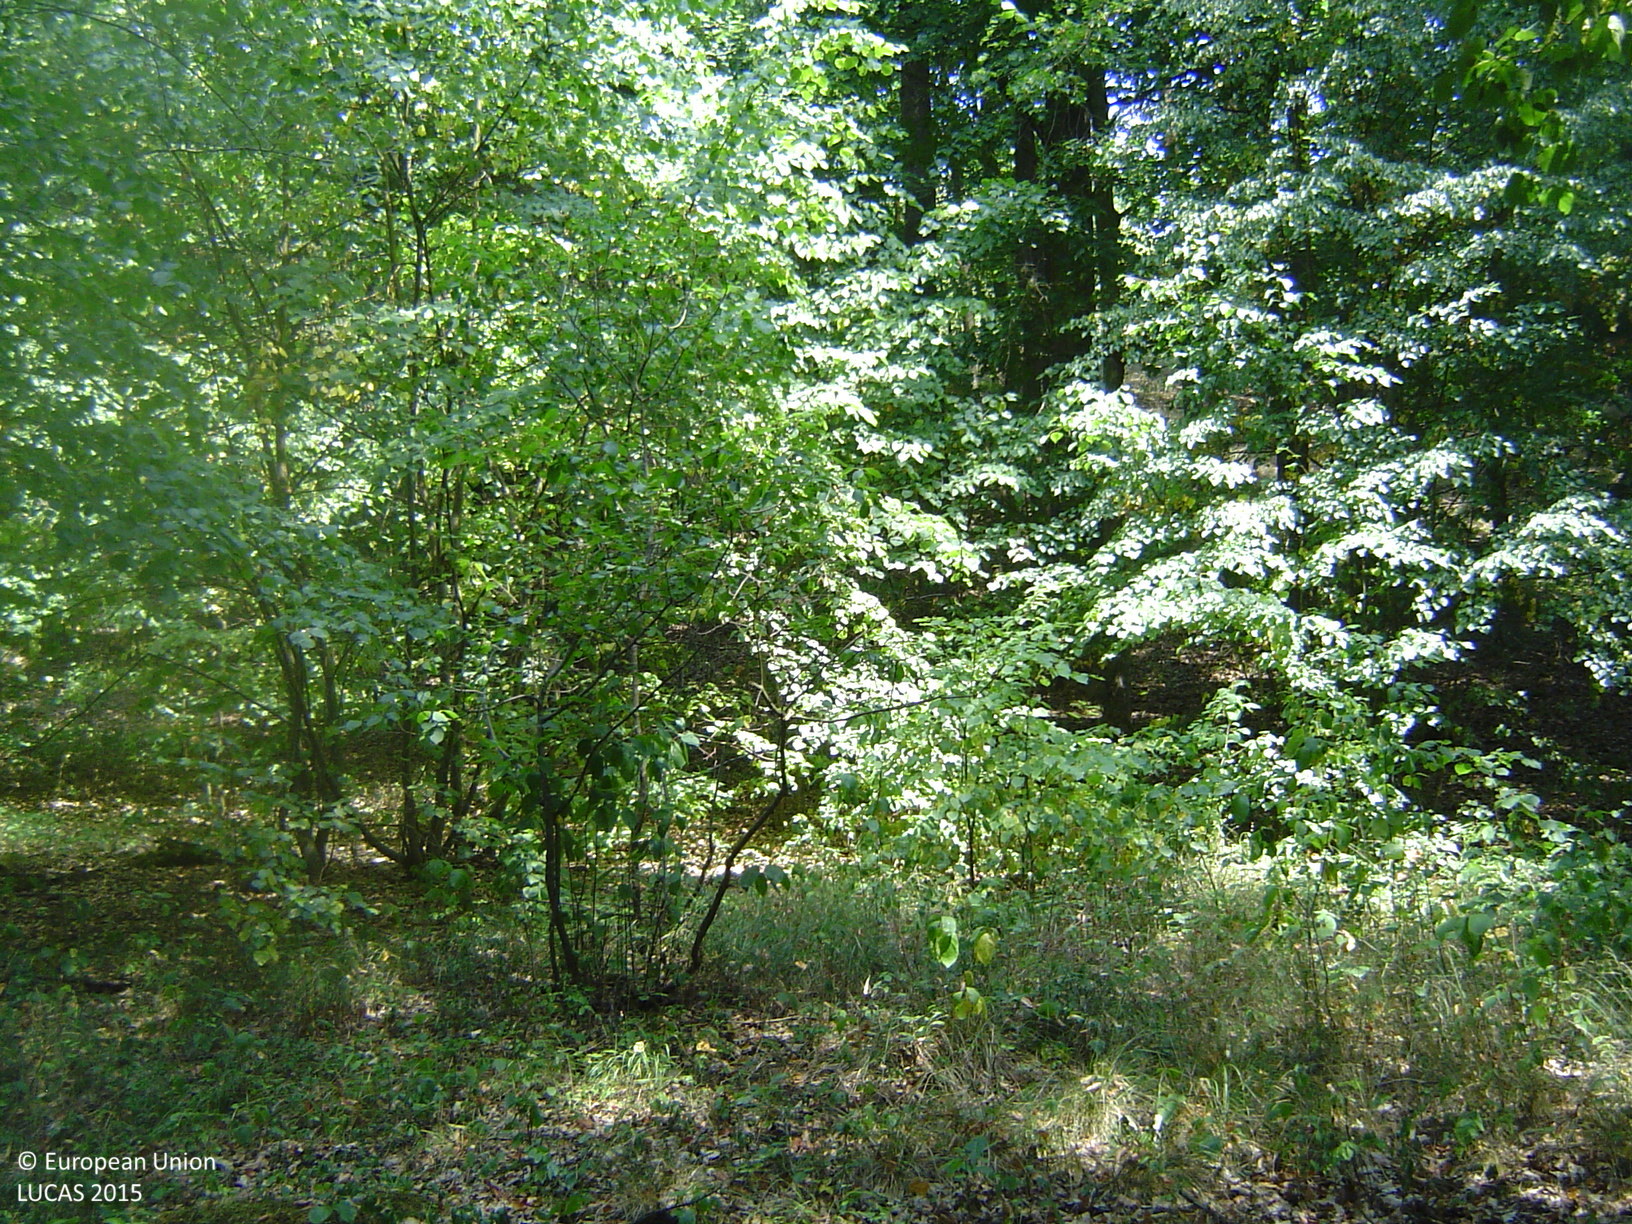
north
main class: Woodland
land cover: Broadleaved woodland
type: mesophytic deciduous forest
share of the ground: > 75 %
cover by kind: broadleaved forest trees 100 %
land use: Forestry
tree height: > 5 m
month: July
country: CZ
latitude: 49.0966
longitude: 16.1822
